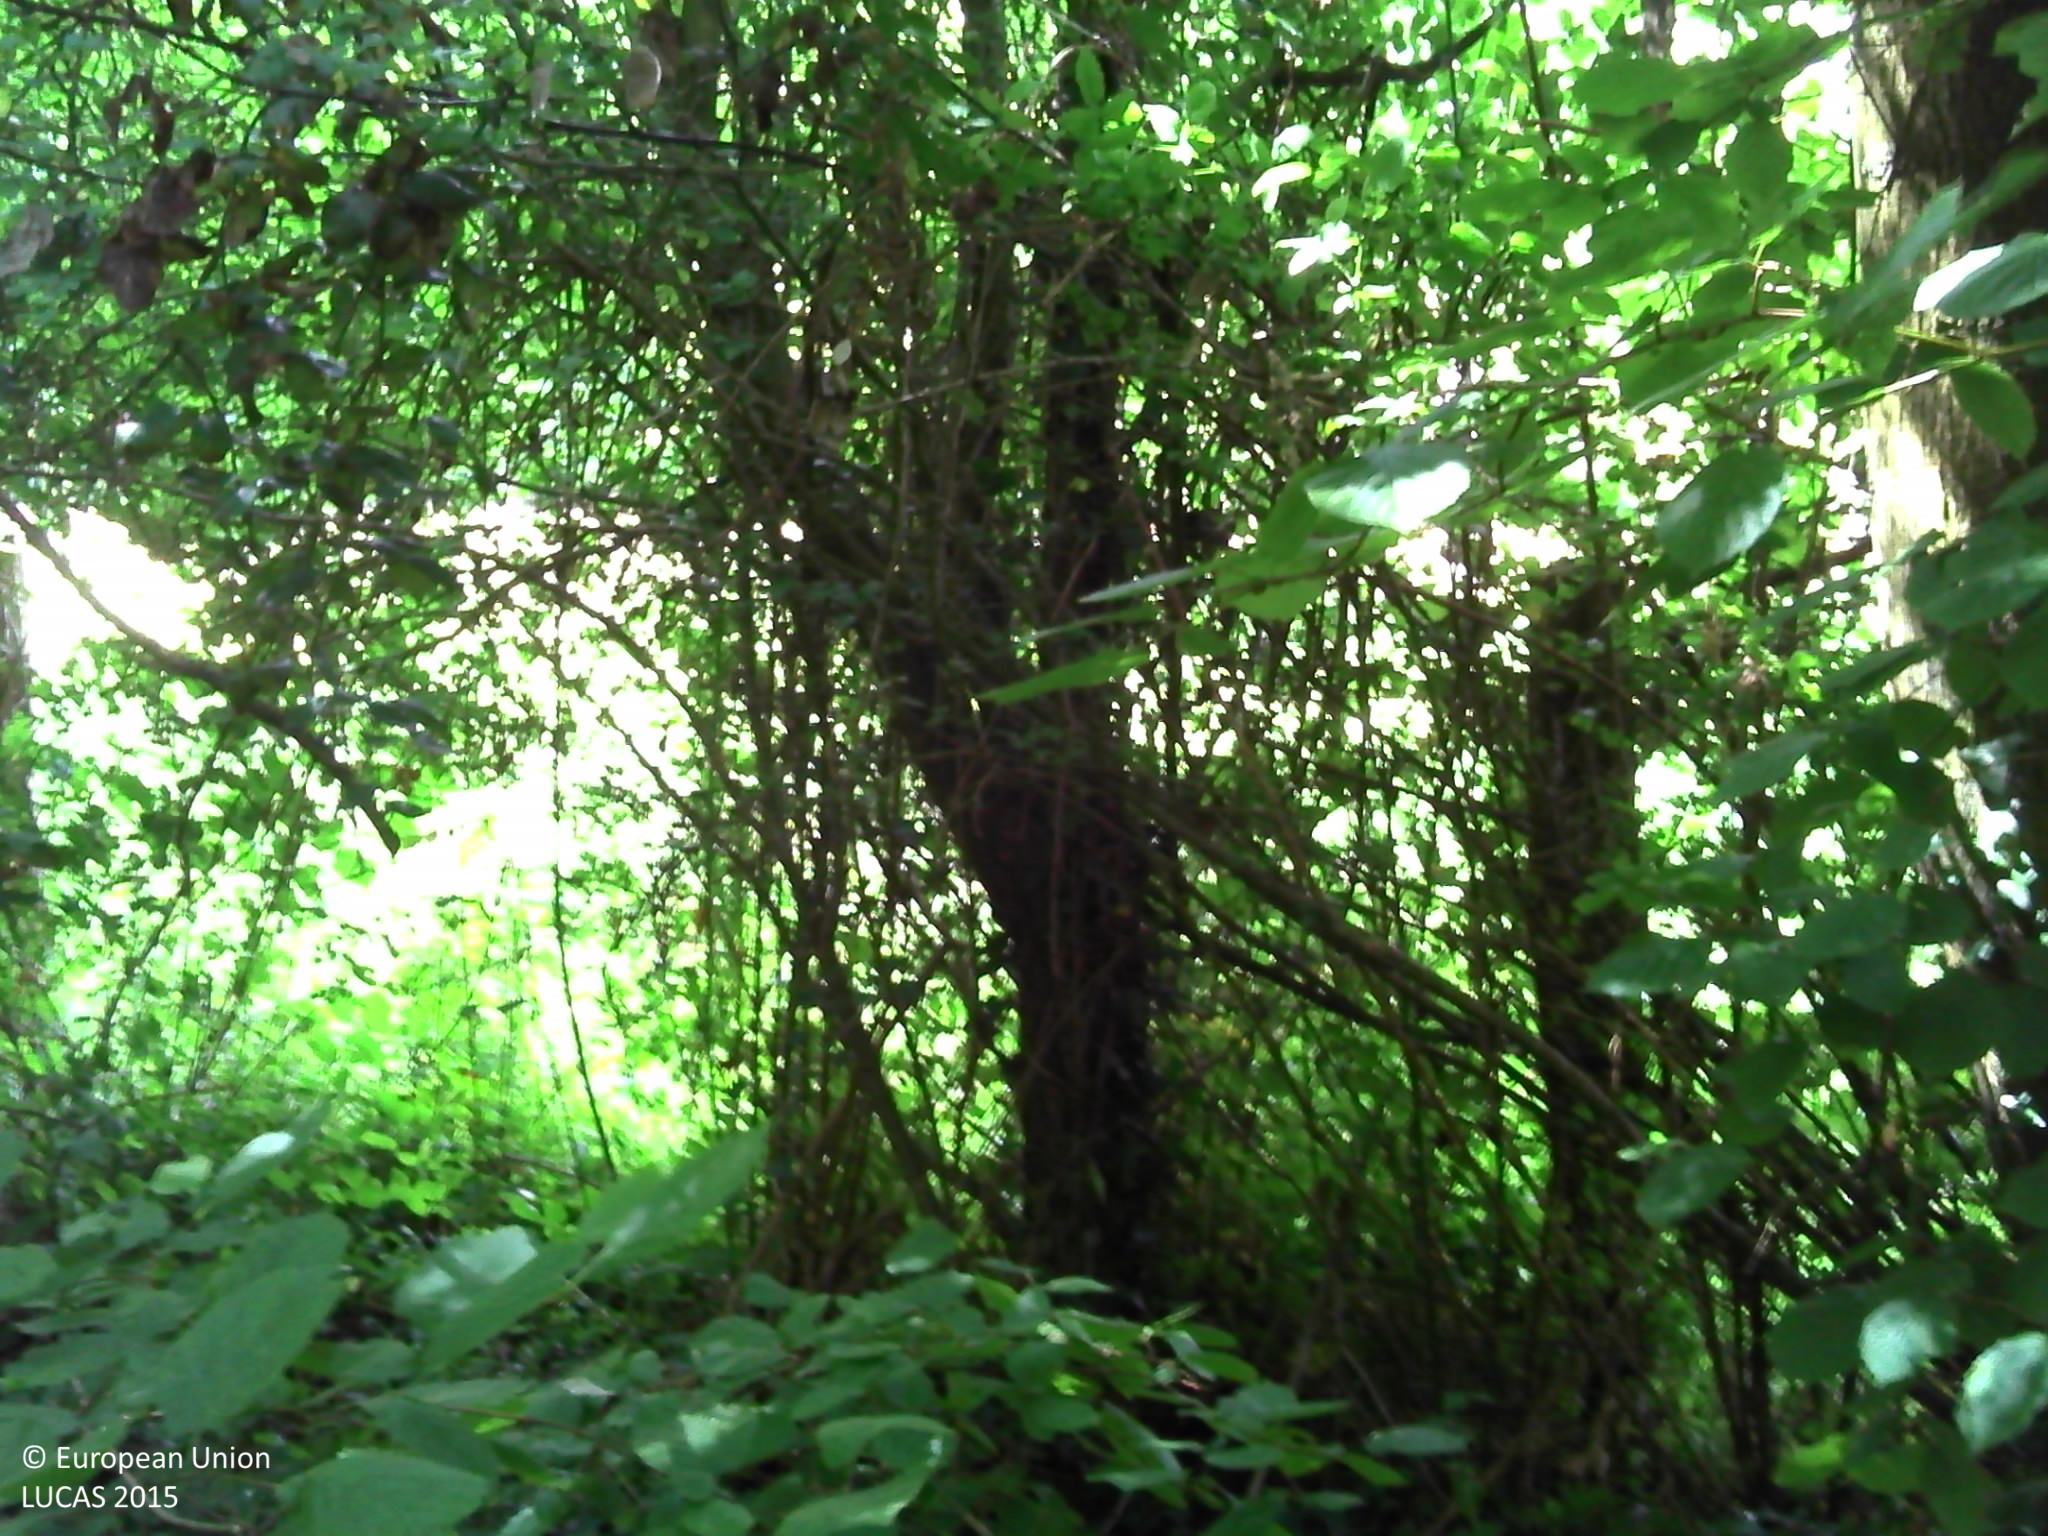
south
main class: Woodland
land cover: Broadleaved woodland
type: mesophytic deciduous forest
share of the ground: > 75 %
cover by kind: broadleaved forest trees 70 %, shrubs 20 %, herbaceous plants 10 %
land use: Semi-natural and natural areas not in use
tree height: > 5 m
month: July
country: FR
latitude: 48.9431
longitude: -0.2320
